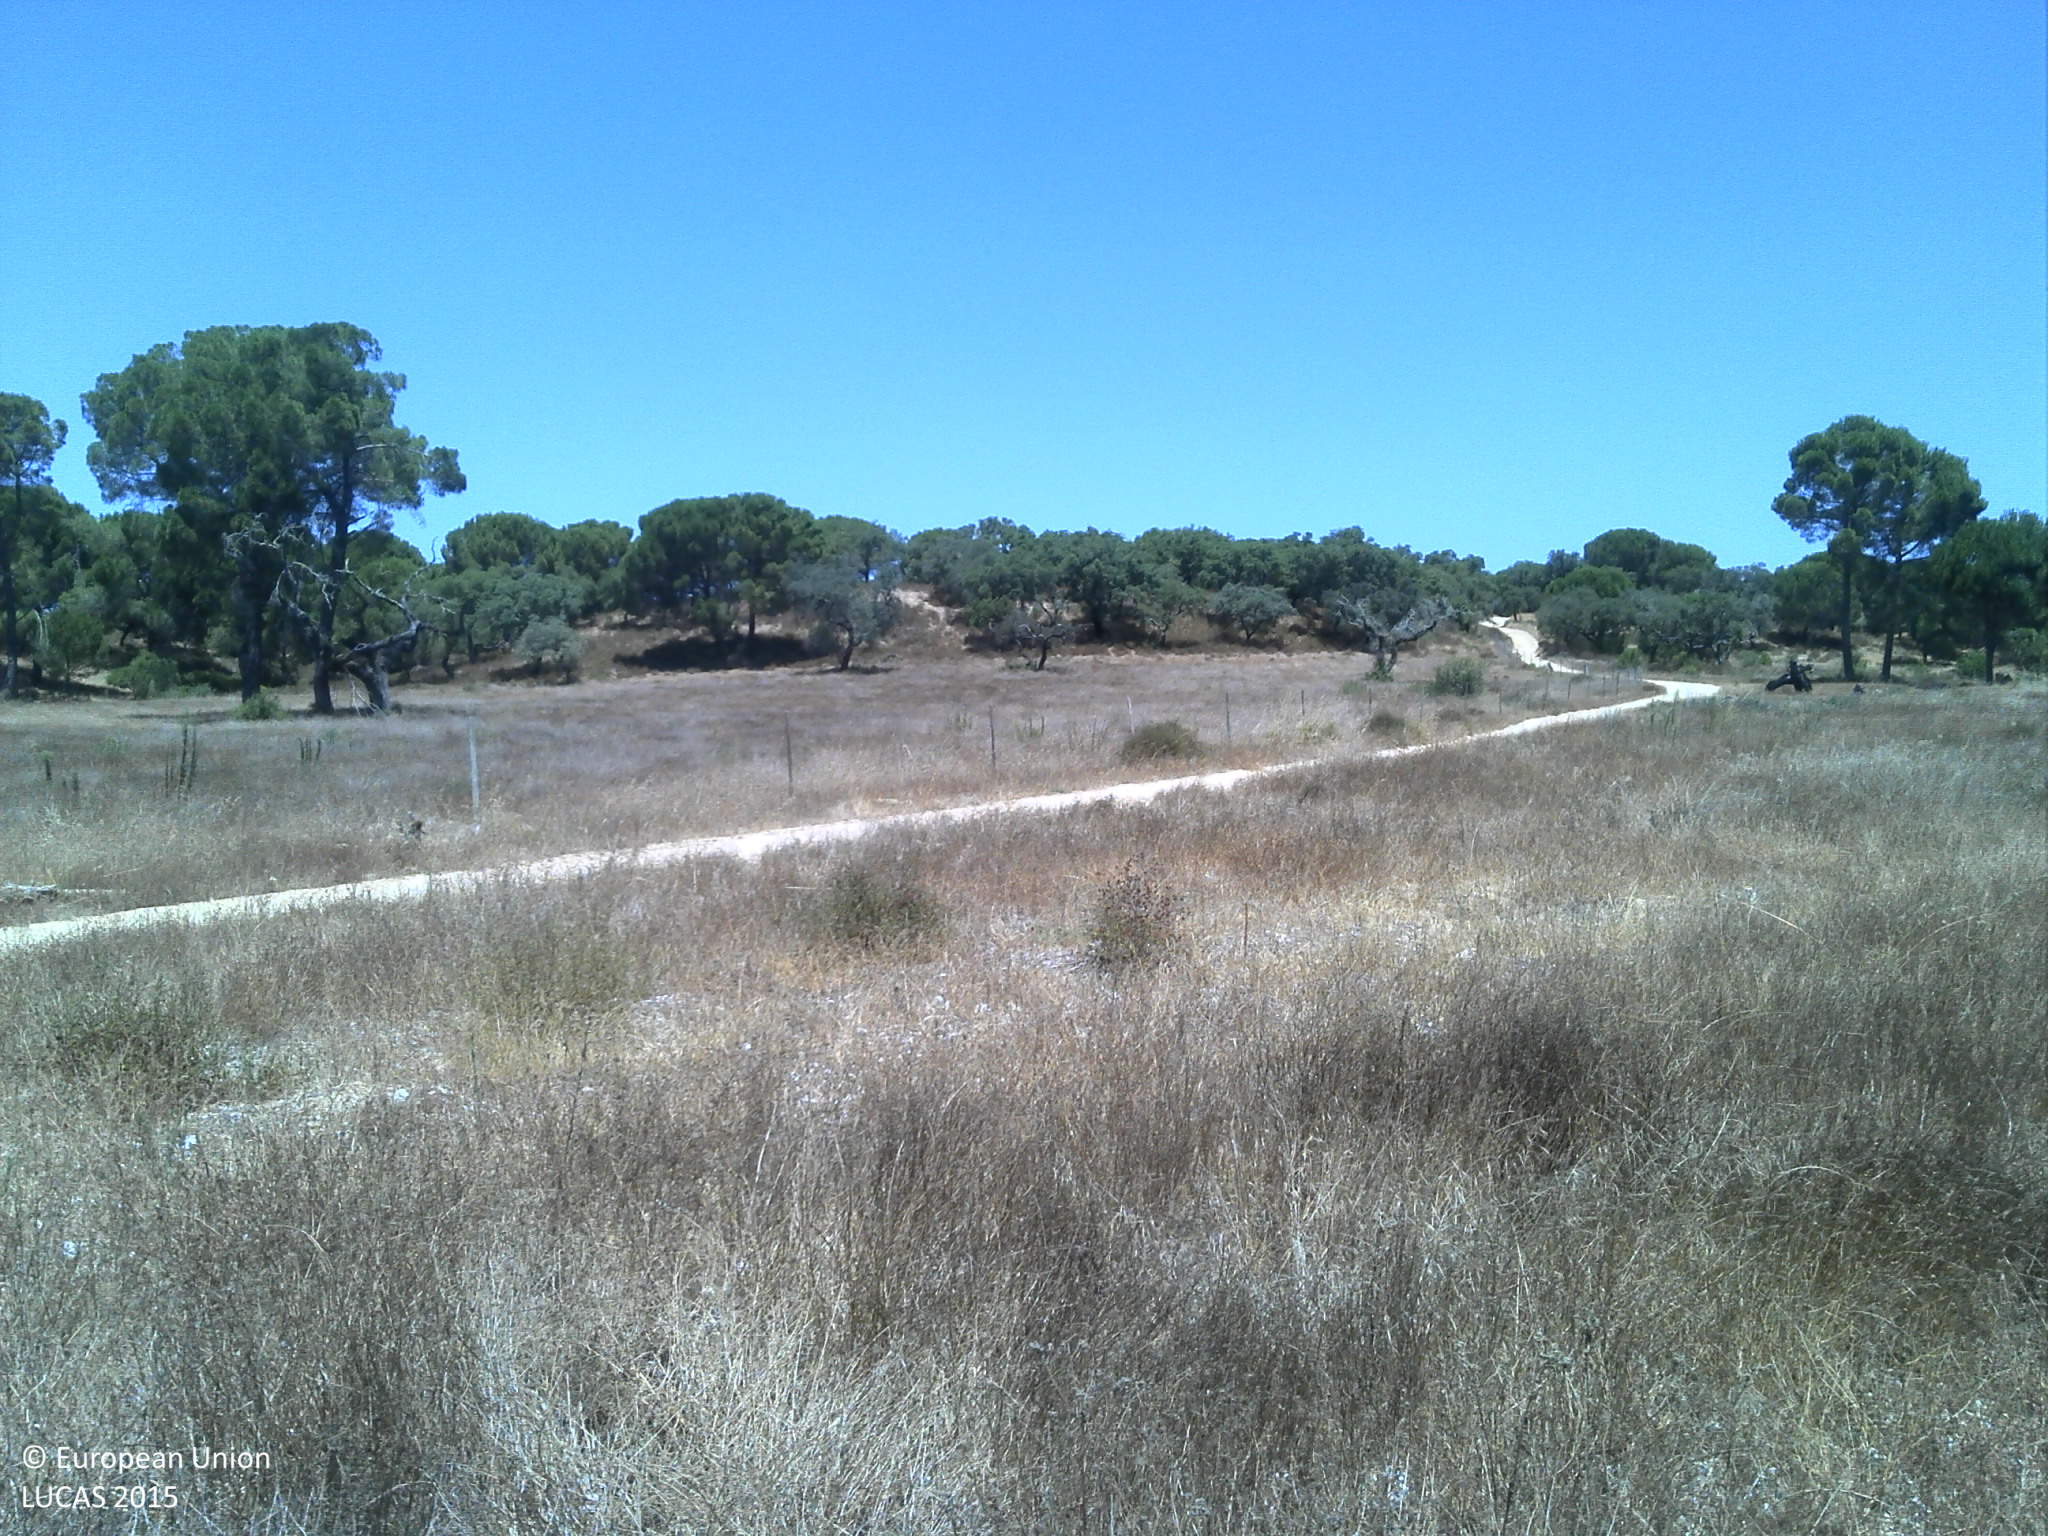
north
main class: Grassland
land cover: Spontaneously vegetated surfaces
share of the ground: 50 - 75 %
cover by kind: herbaceous plants 90 %, unconsolidated bare surface 10 %
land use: Fallow land
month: July
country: PT
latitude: 38.9985
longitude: -8.2654
